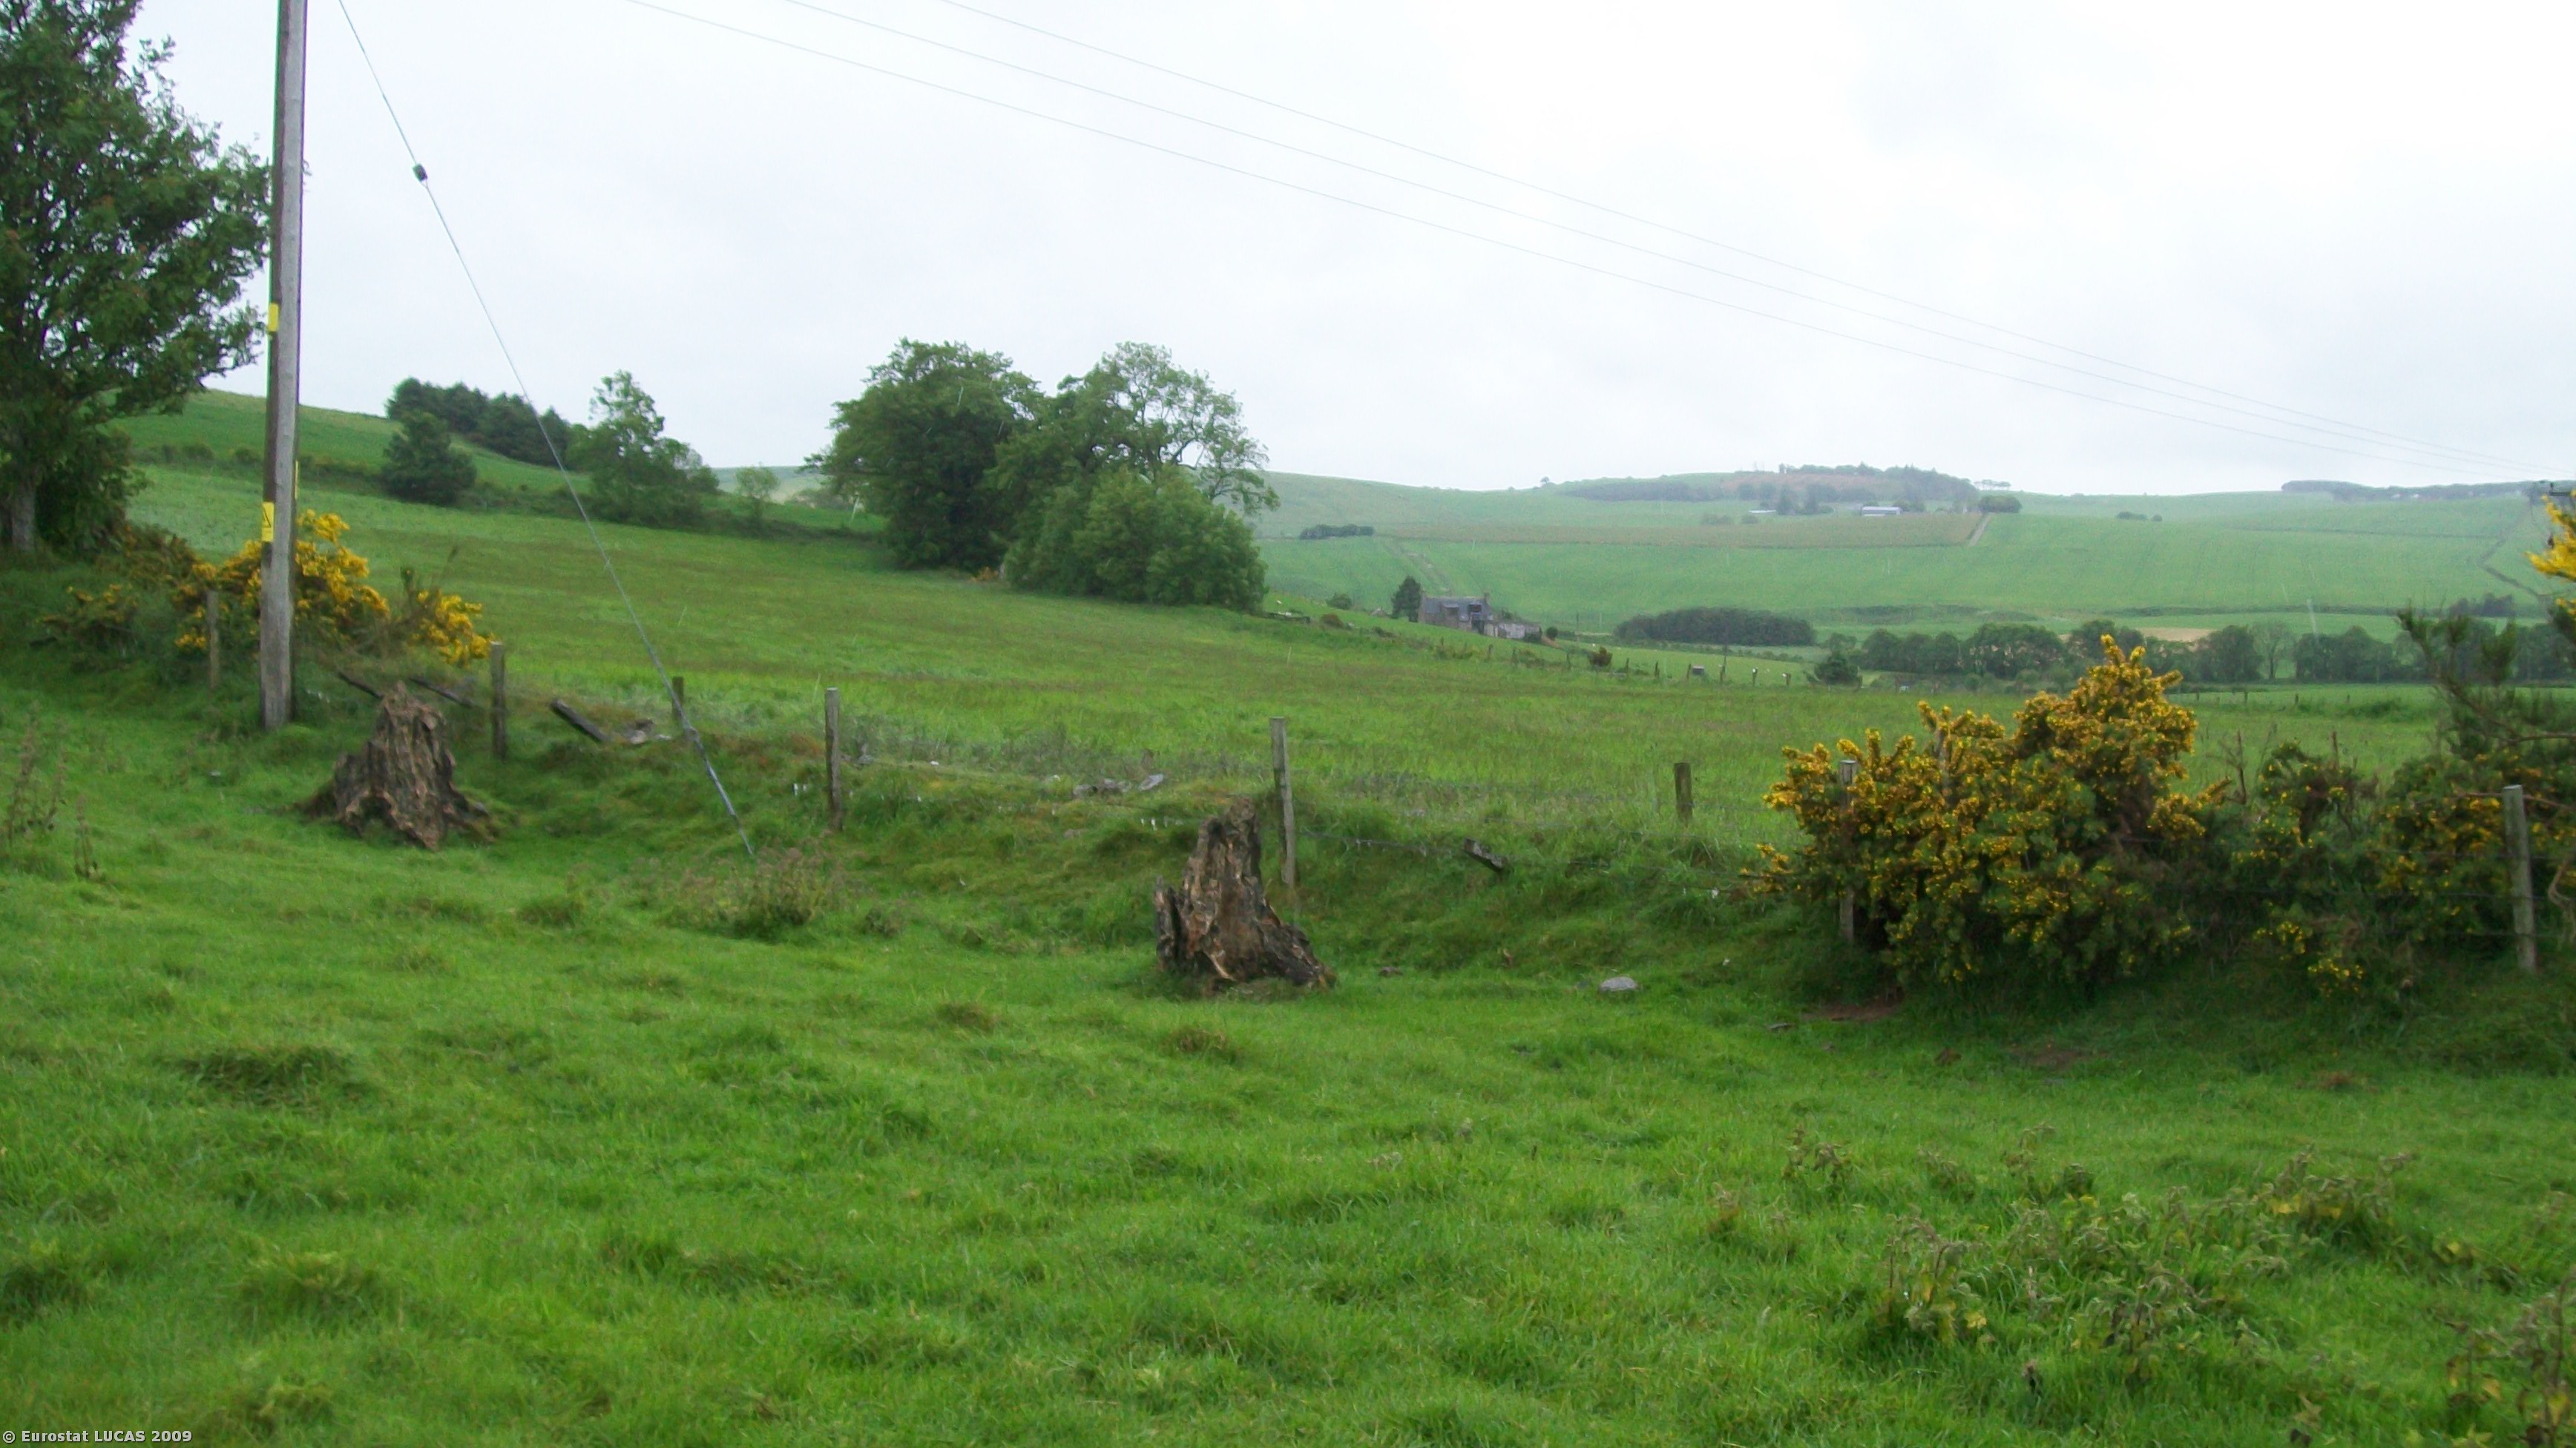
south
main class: Grassland
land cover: Grassland without tree/shrub cover
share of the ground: > 75 %
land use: Agriculture (excluding fallow land and kitchen gardens)
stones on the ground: < 10 %
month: June
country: GB
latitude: 57.6271
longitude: -2.5620
